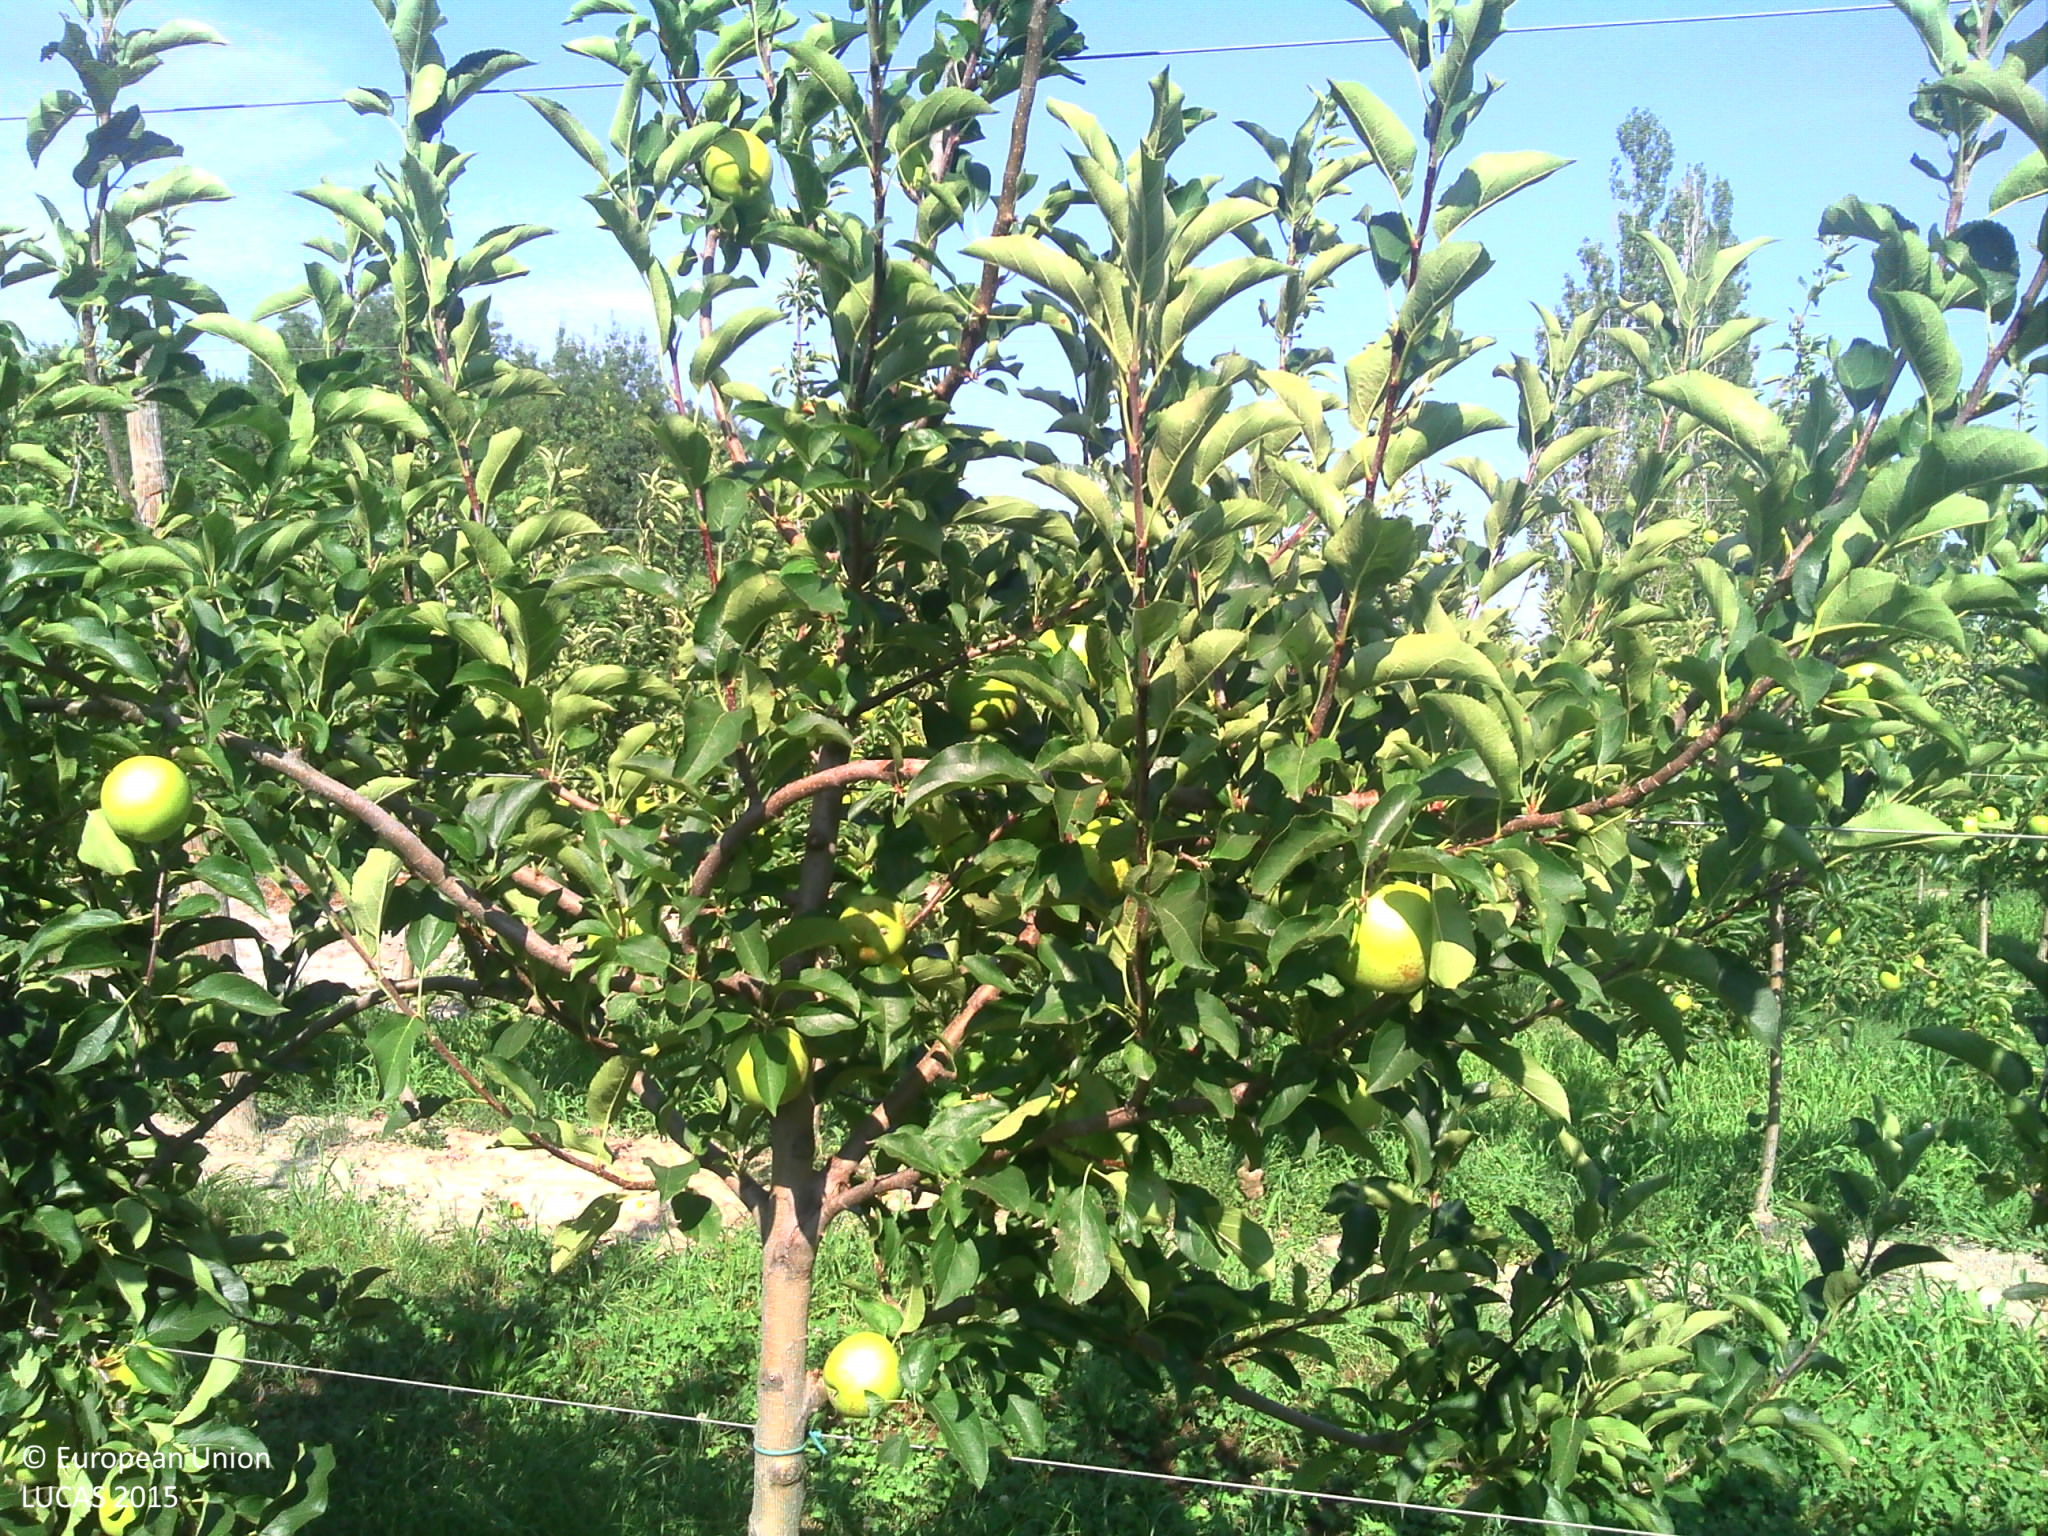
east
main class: Cropland
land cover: Apple fruit
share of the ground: 50 - 75 %
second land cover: Grassland without tree/shrub cover
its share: 25 - 50 %
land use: Agriculture (excluding fallow land and kitchen gardens)
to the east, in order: Apple fruit; Grassland without tree/shrub cover; Grassland with sparse tree/shrub cover; Other bare soil; Grass margins; Conifer hedges; Ditches and canals; Grass margins; Tracks; Grass margins; Inland fresh running water; Shrubland without tree cover; Broadleaved woodland
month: July
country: FR
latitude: 43.8008
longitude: 4.7265
